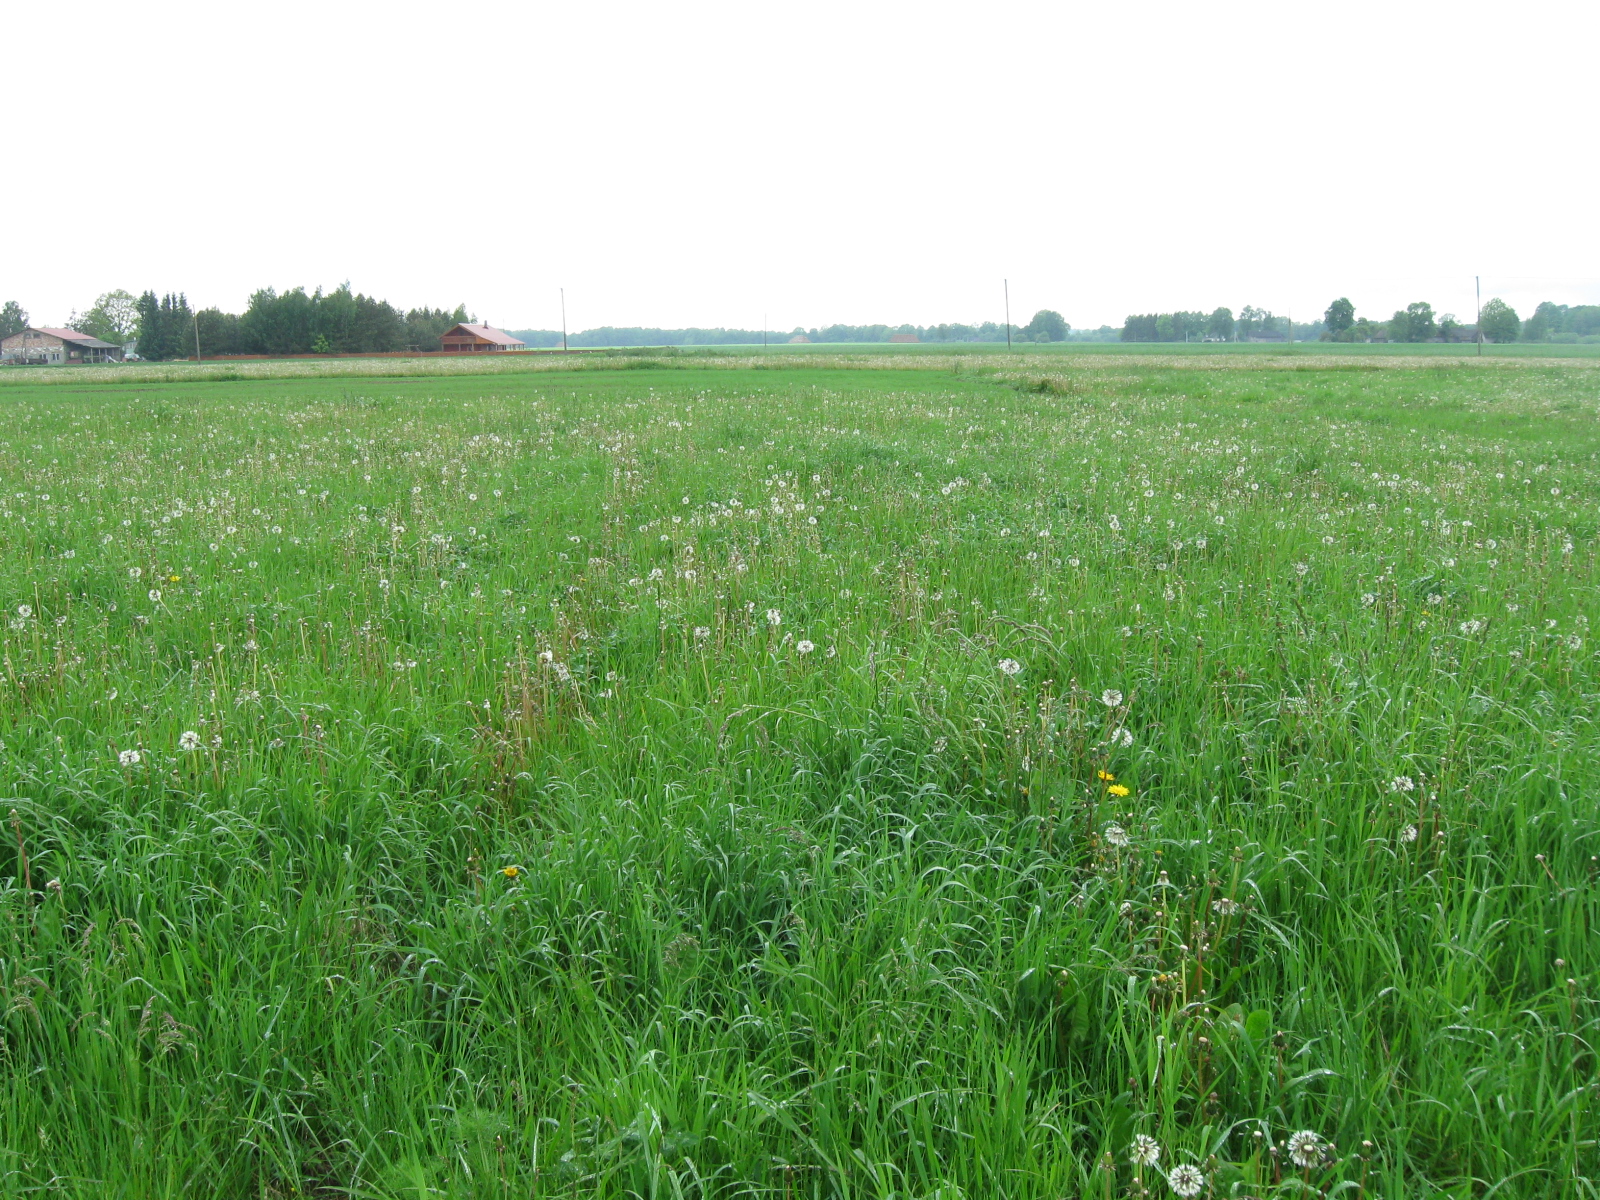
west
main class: Grassland
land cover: Grassland without tree/shrub cover
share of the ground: > 75 %
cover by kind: herbaceous plants 100 %
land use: Agriculture (excluding fallow land and kitchen gardens)
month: May
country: LT
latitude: 55.0166
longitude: 22.7822
